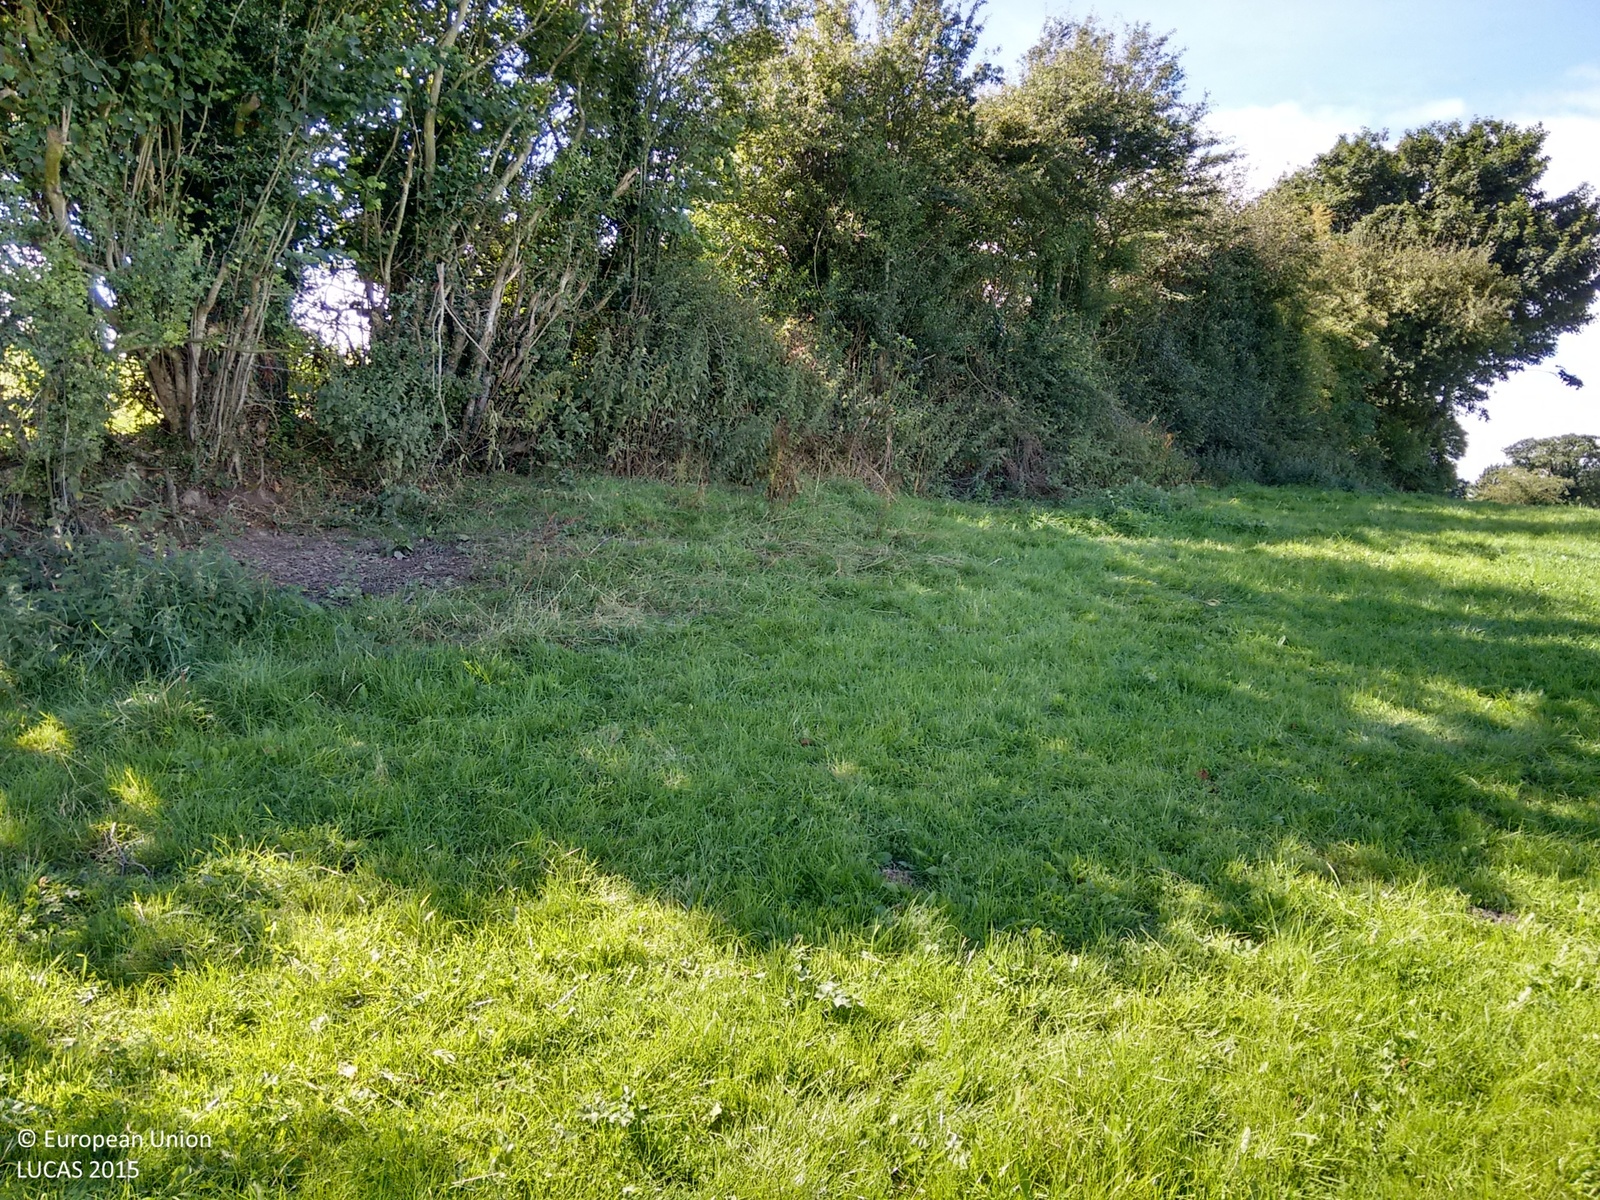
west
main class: Grassland
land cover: Grassland without tree/shrub cover
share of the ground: > 75 %
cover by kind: herbaceous plants 100 %
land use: Agriculture (excluding fallow land and kitchen gardens)
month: August
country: IE
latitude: 53.3636
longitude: -7.5152
